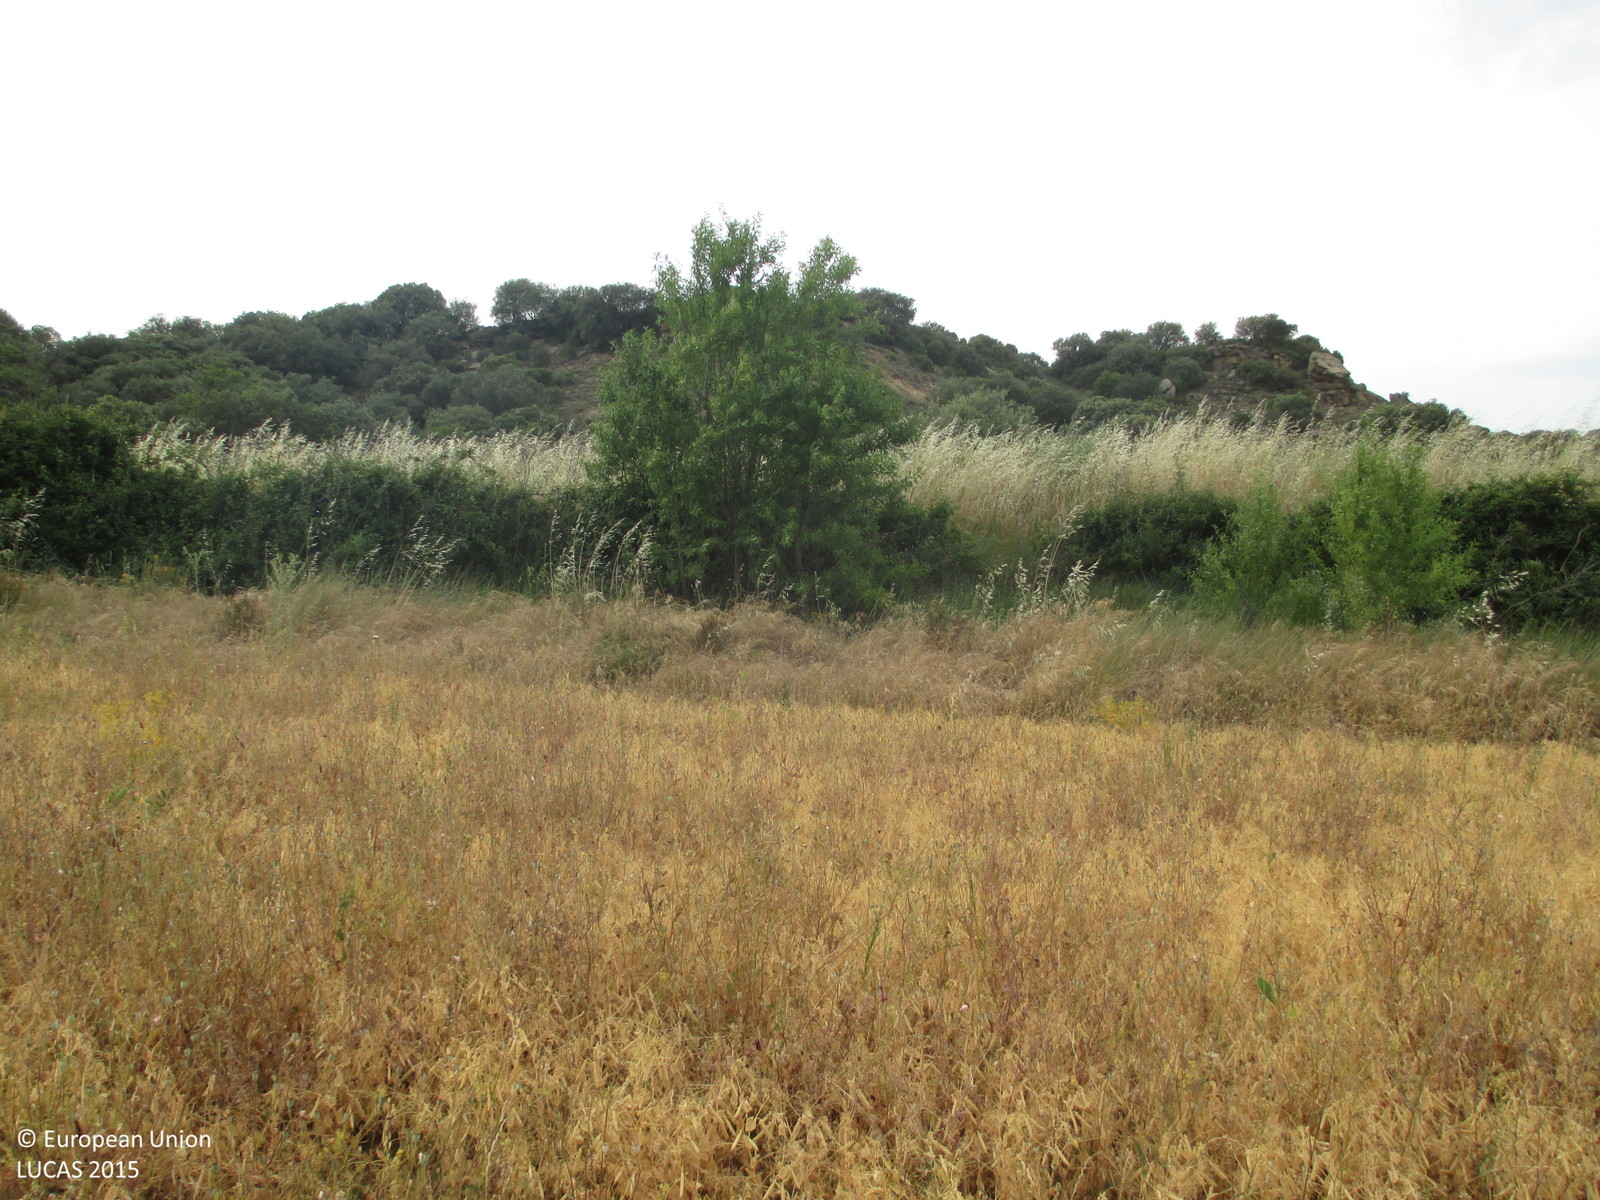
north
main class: Cropland
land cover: Dry pulses
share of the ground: > 75 %
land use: Agriculture (excluding fallow land and kitchen gardens)
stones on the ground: < 10 %
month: May
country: ES
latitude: 42.1154
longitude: -0.2412
